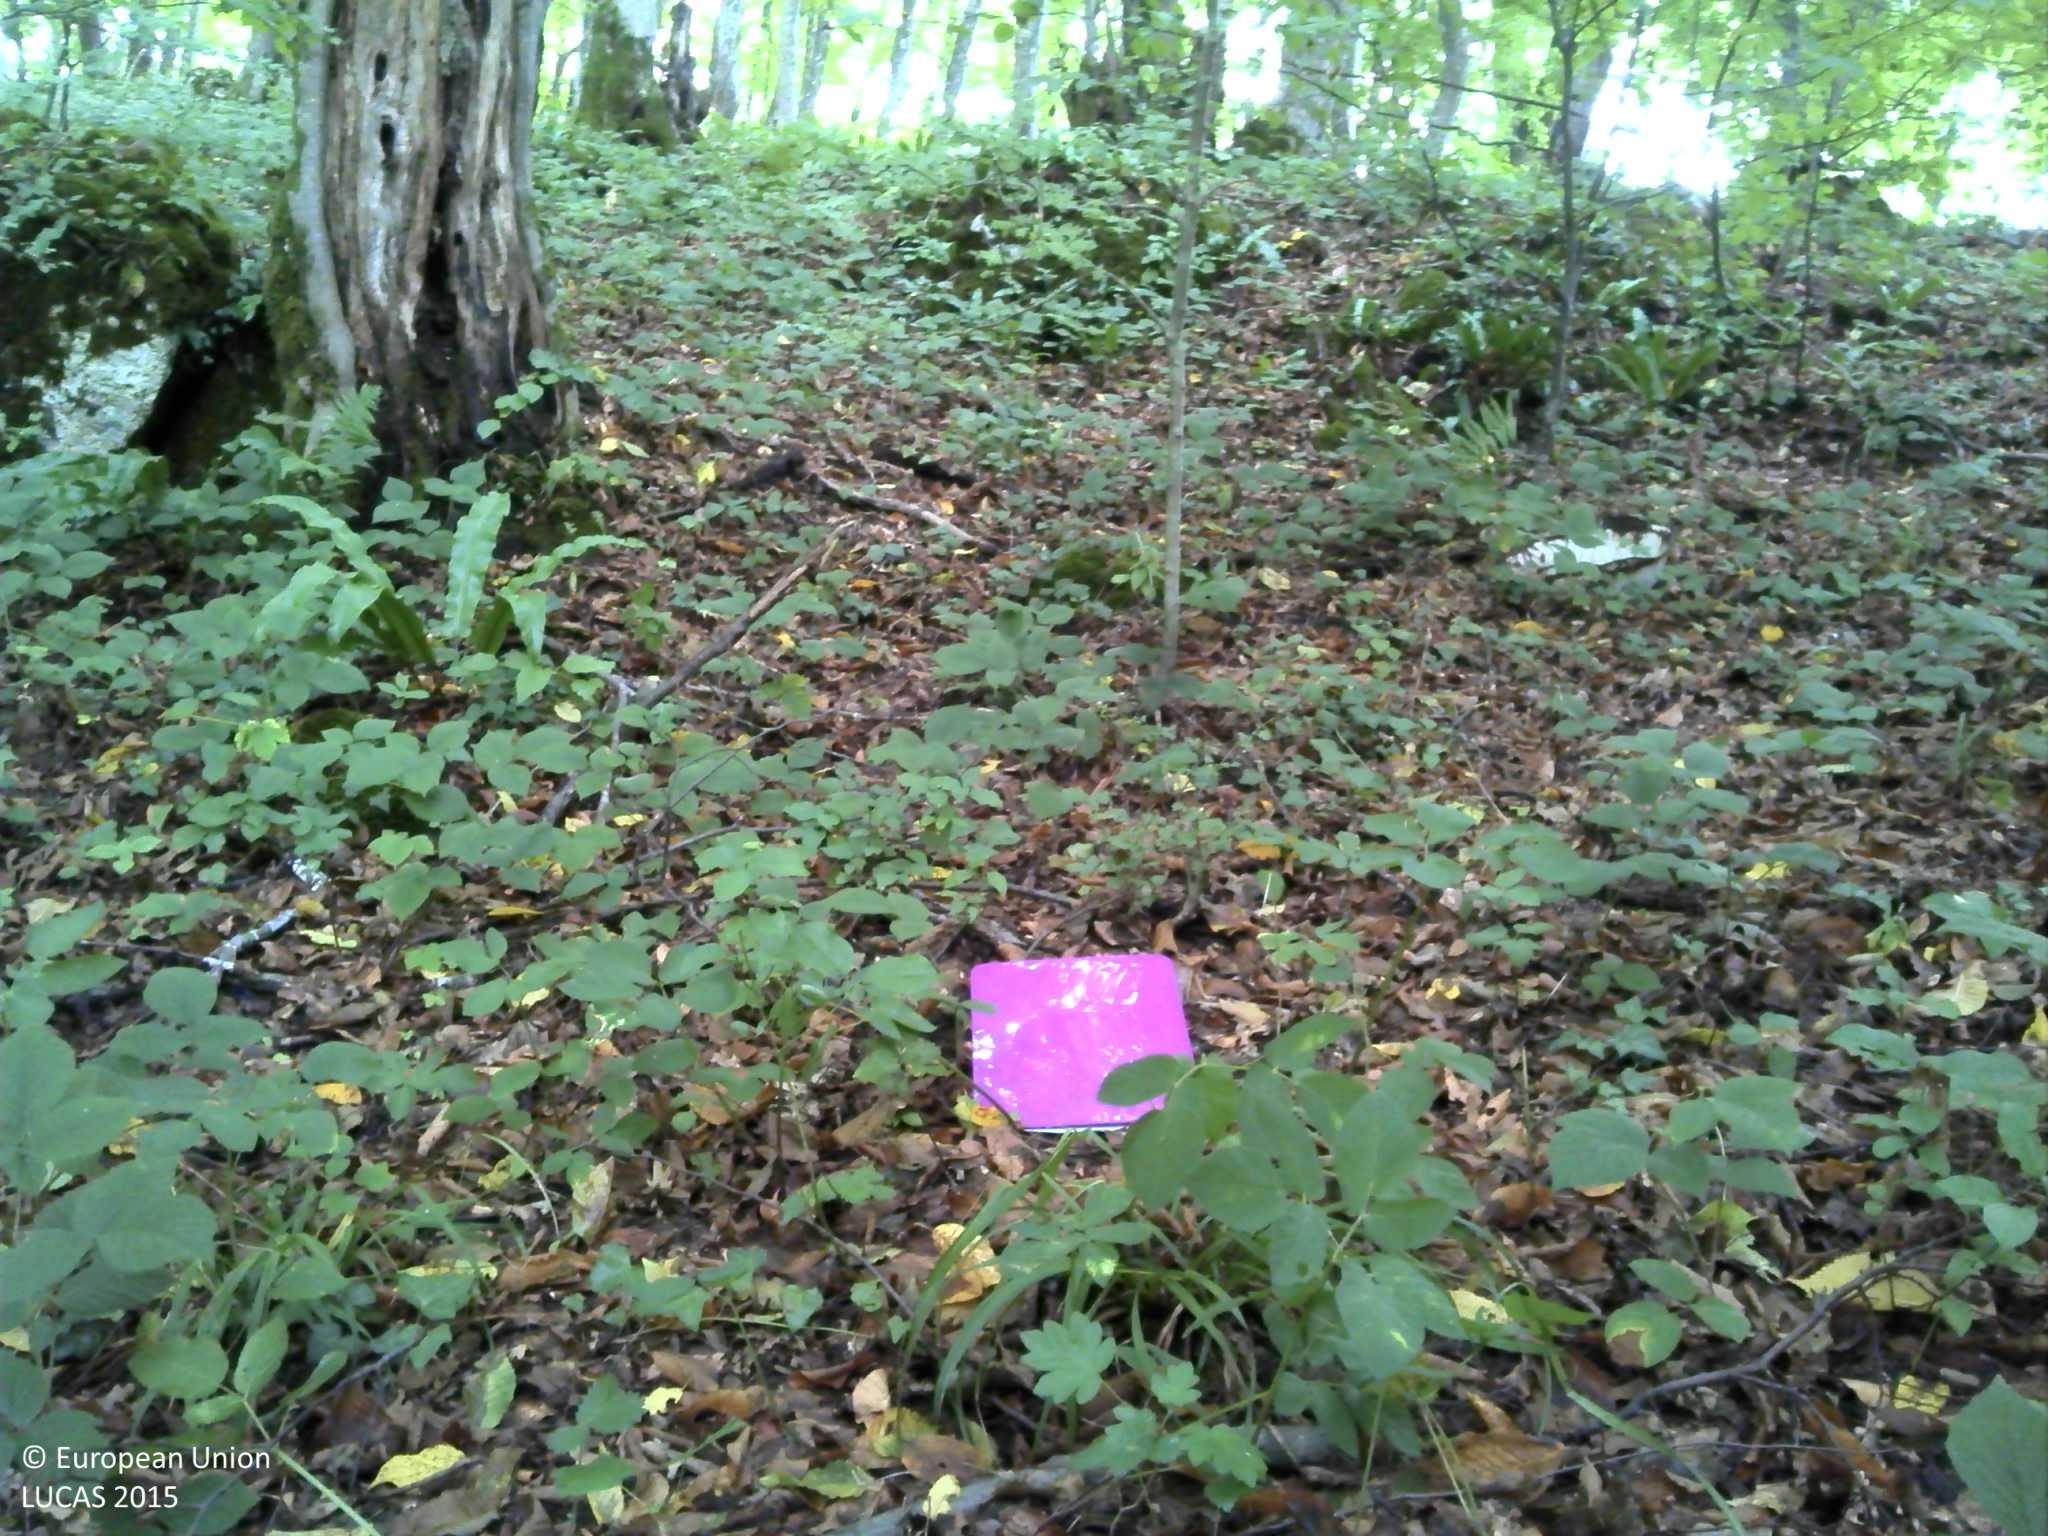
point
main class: Woodland
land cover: Broadleaved woodland
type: beech forest
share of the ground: > 75 %
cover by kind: broadleaved forest trees 100 %
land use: Forestry
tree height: > 5 m
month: August
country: HR
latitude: 45.2439
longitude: 15.6650
